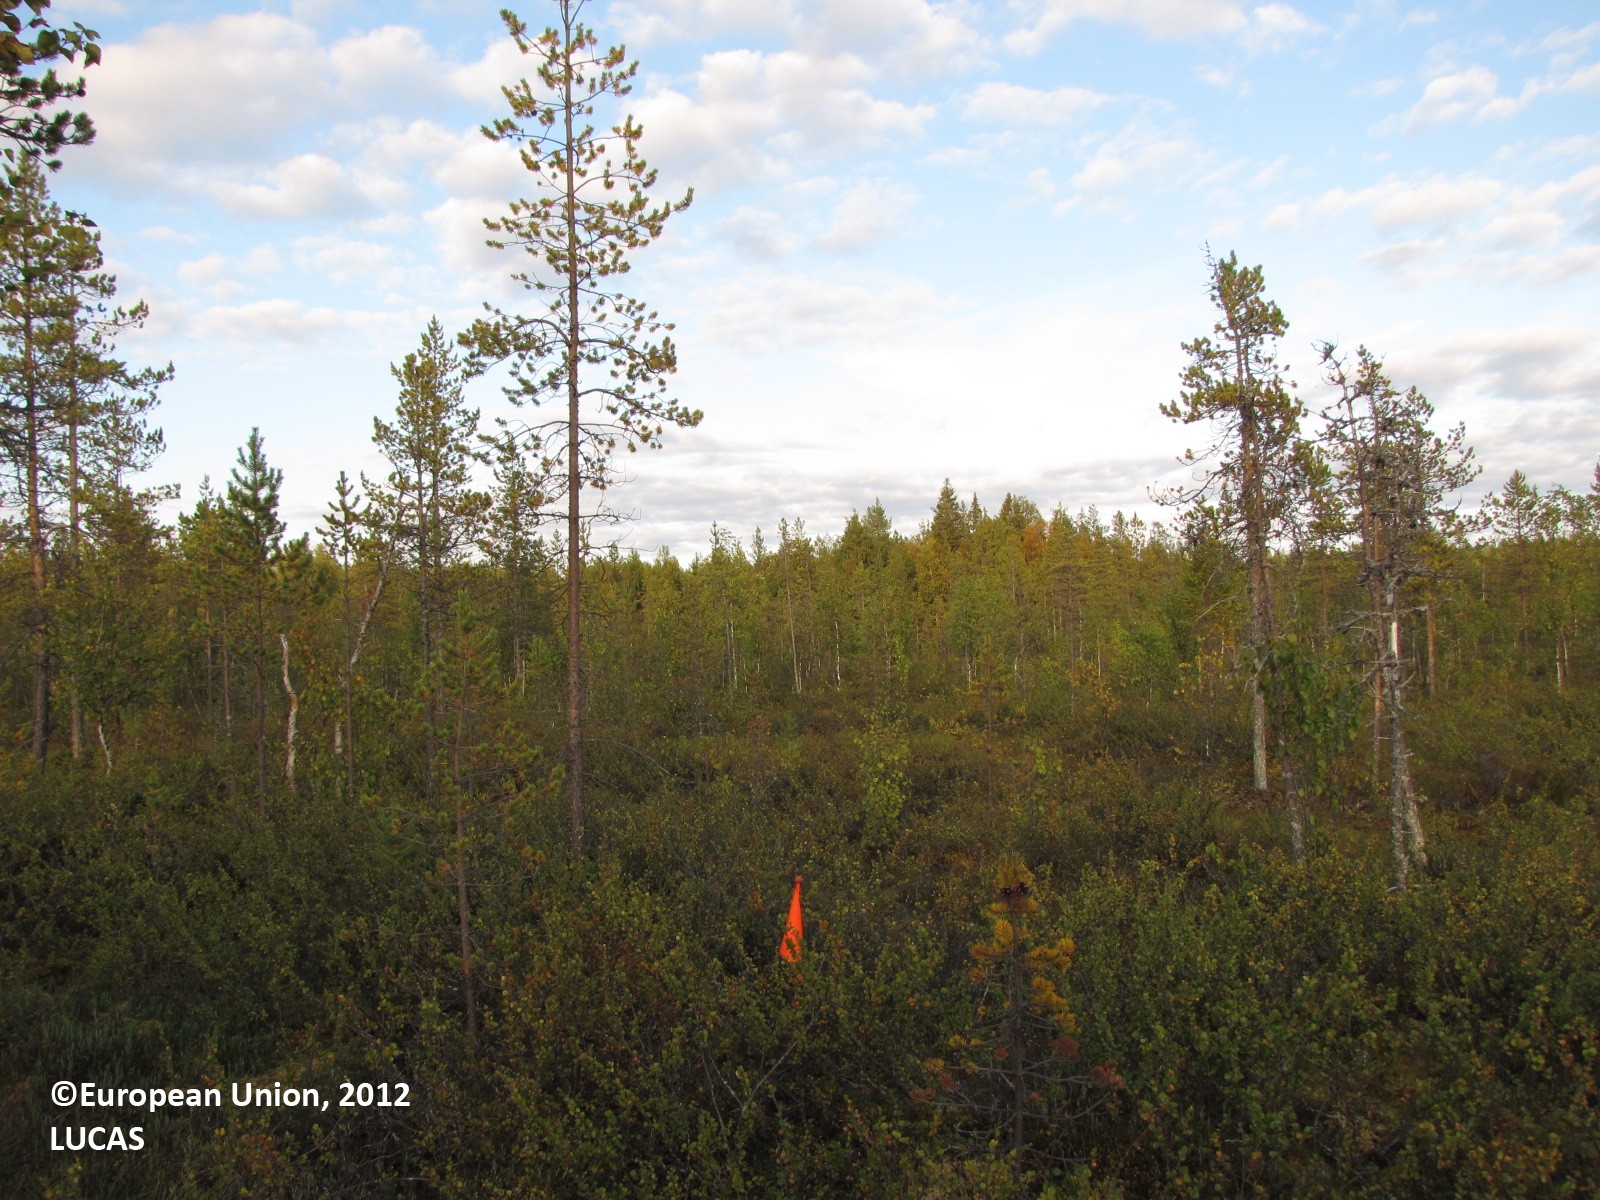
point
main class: Woodland
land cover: Pine dominated mixed woodland
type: boreal forest
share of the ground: 10 - 25 %
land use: Forestry
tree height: > 5 m
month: August
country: FI
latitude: 67.0580
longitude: 25.0591
